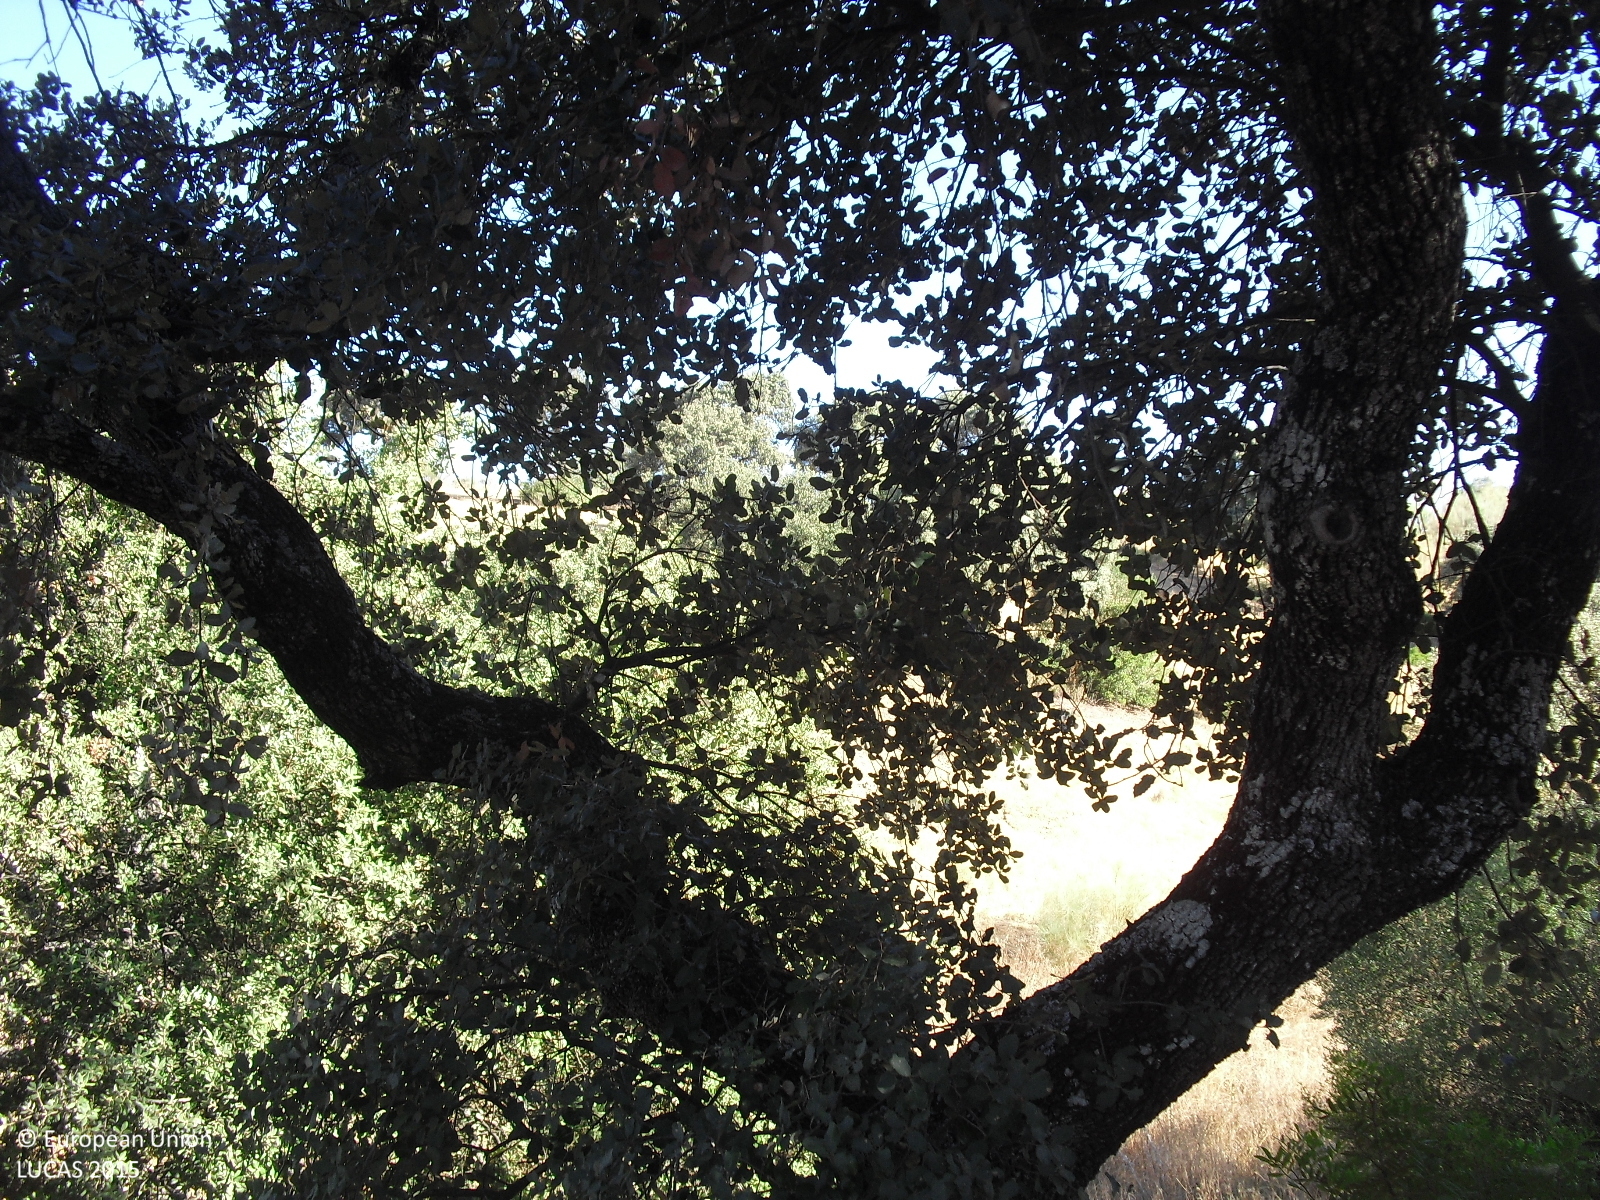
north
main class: Woodland
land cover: Broadleaved woodland
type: broadleaved evergreen forest
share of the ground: 25 - 50 %
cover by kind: herbaceous plants 65 %, broadleaved forest trees 30 %, shrubs 5 %
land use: Forestry
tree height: > 5 m
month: July
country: ES
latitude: 37.0236
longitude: -5.3731
